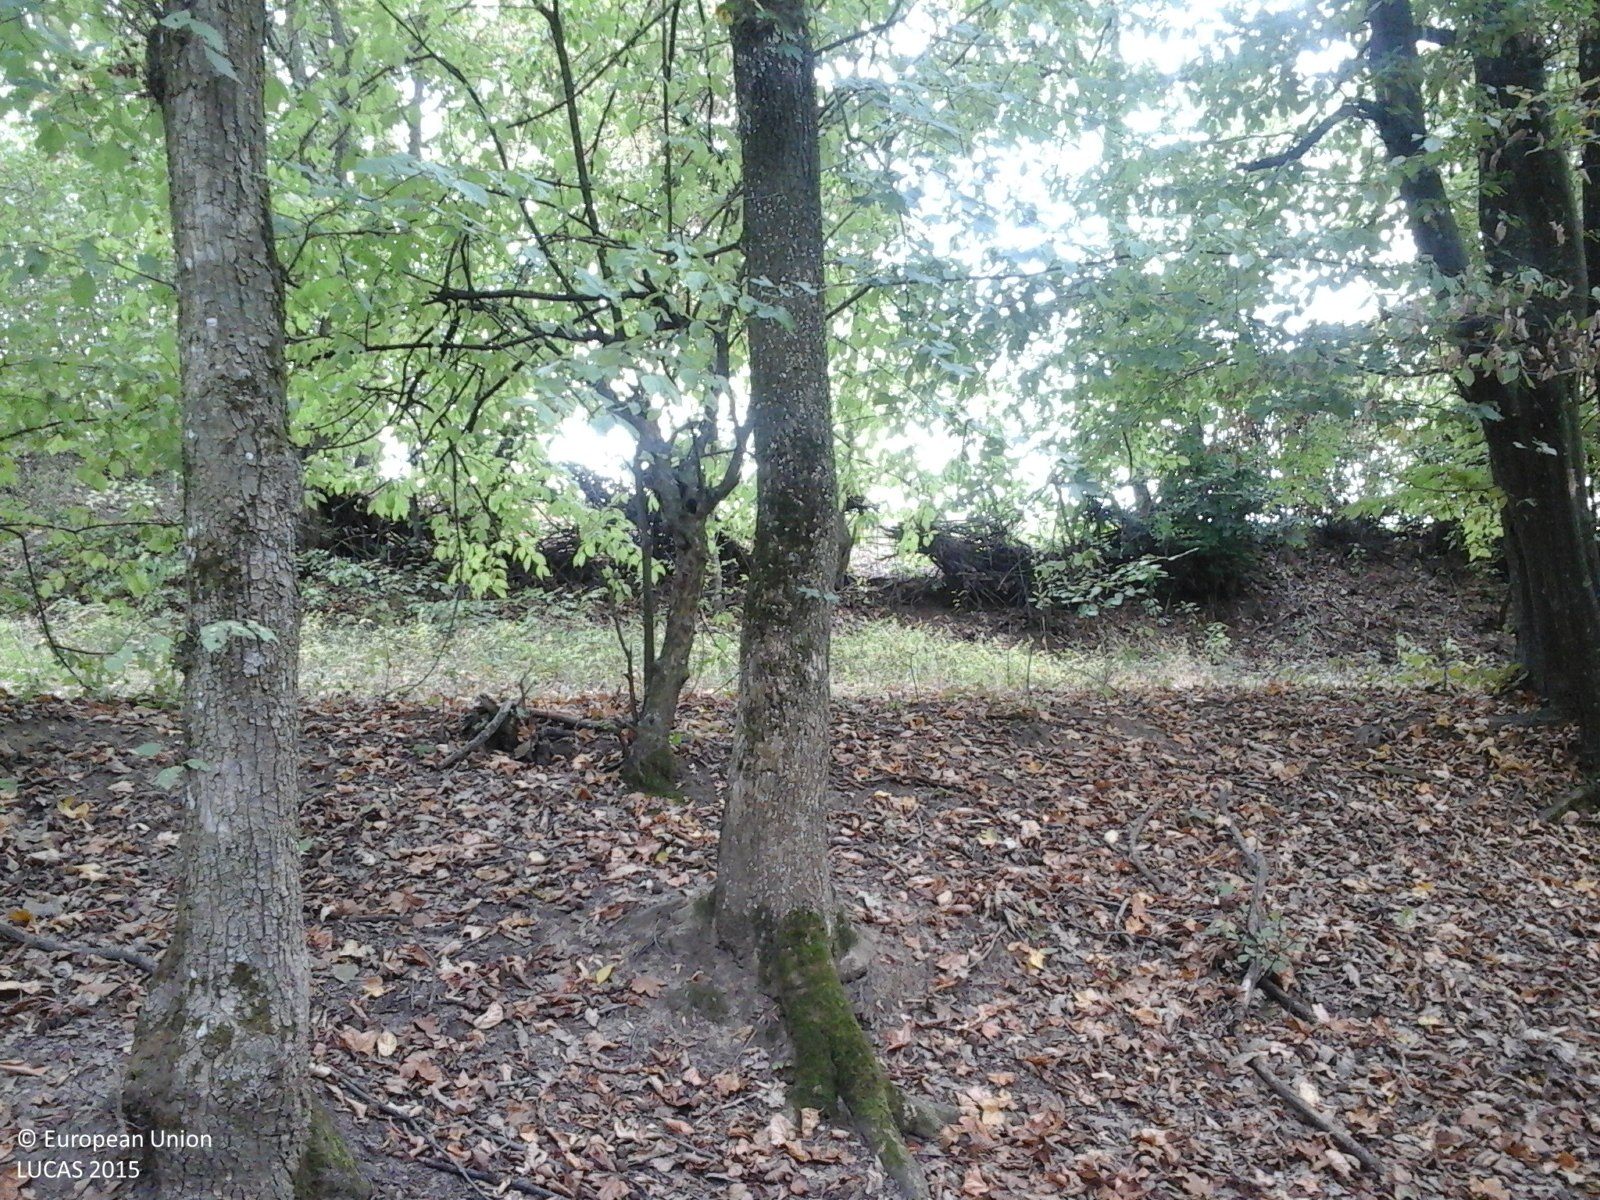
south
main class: Woodland
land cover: Broadleaved woodland
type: mesophytic deciduous forest
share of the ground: > 75 %
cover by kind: broadleaved forest trees 100 %
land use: Forestry
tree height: > 5 m
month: September
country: RO
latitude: 47.3044
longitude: 23.1472
